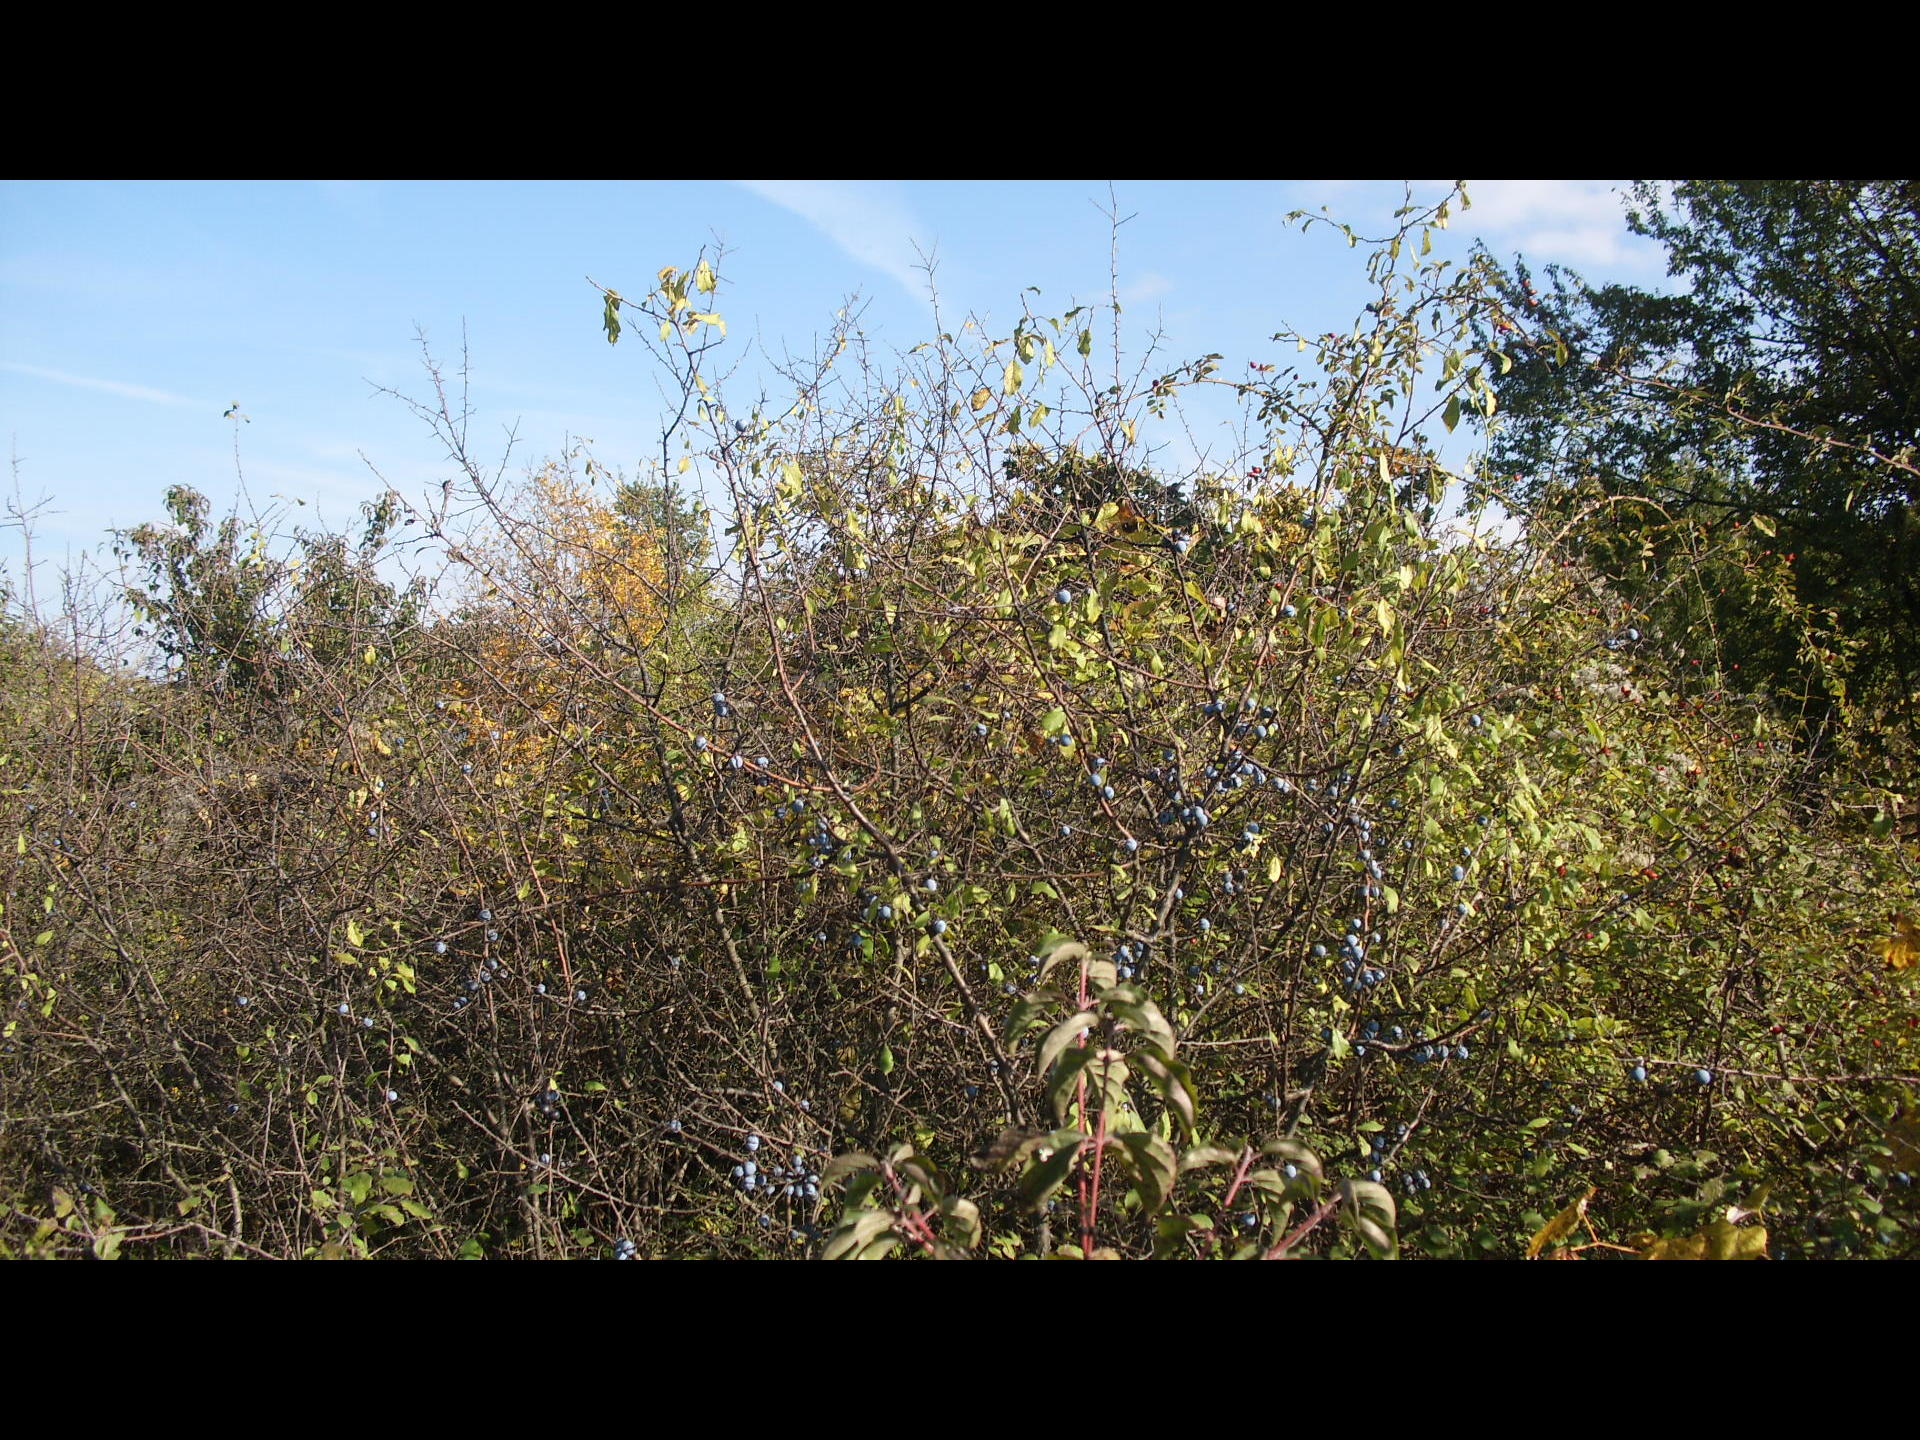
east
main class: Cropland
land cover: Other fruit trees and berries
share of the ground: > 75 %
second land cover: Spontaneously vegetated surfaces
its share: < 10 %
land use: Kitchen garden
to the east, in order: Other fruit trees and berries; Spontaneously vegetated surfaces; Broadleaved woodland; Artificial constructions in urban areas
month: October
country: BG
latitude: 43.4129
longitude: 23.1916
